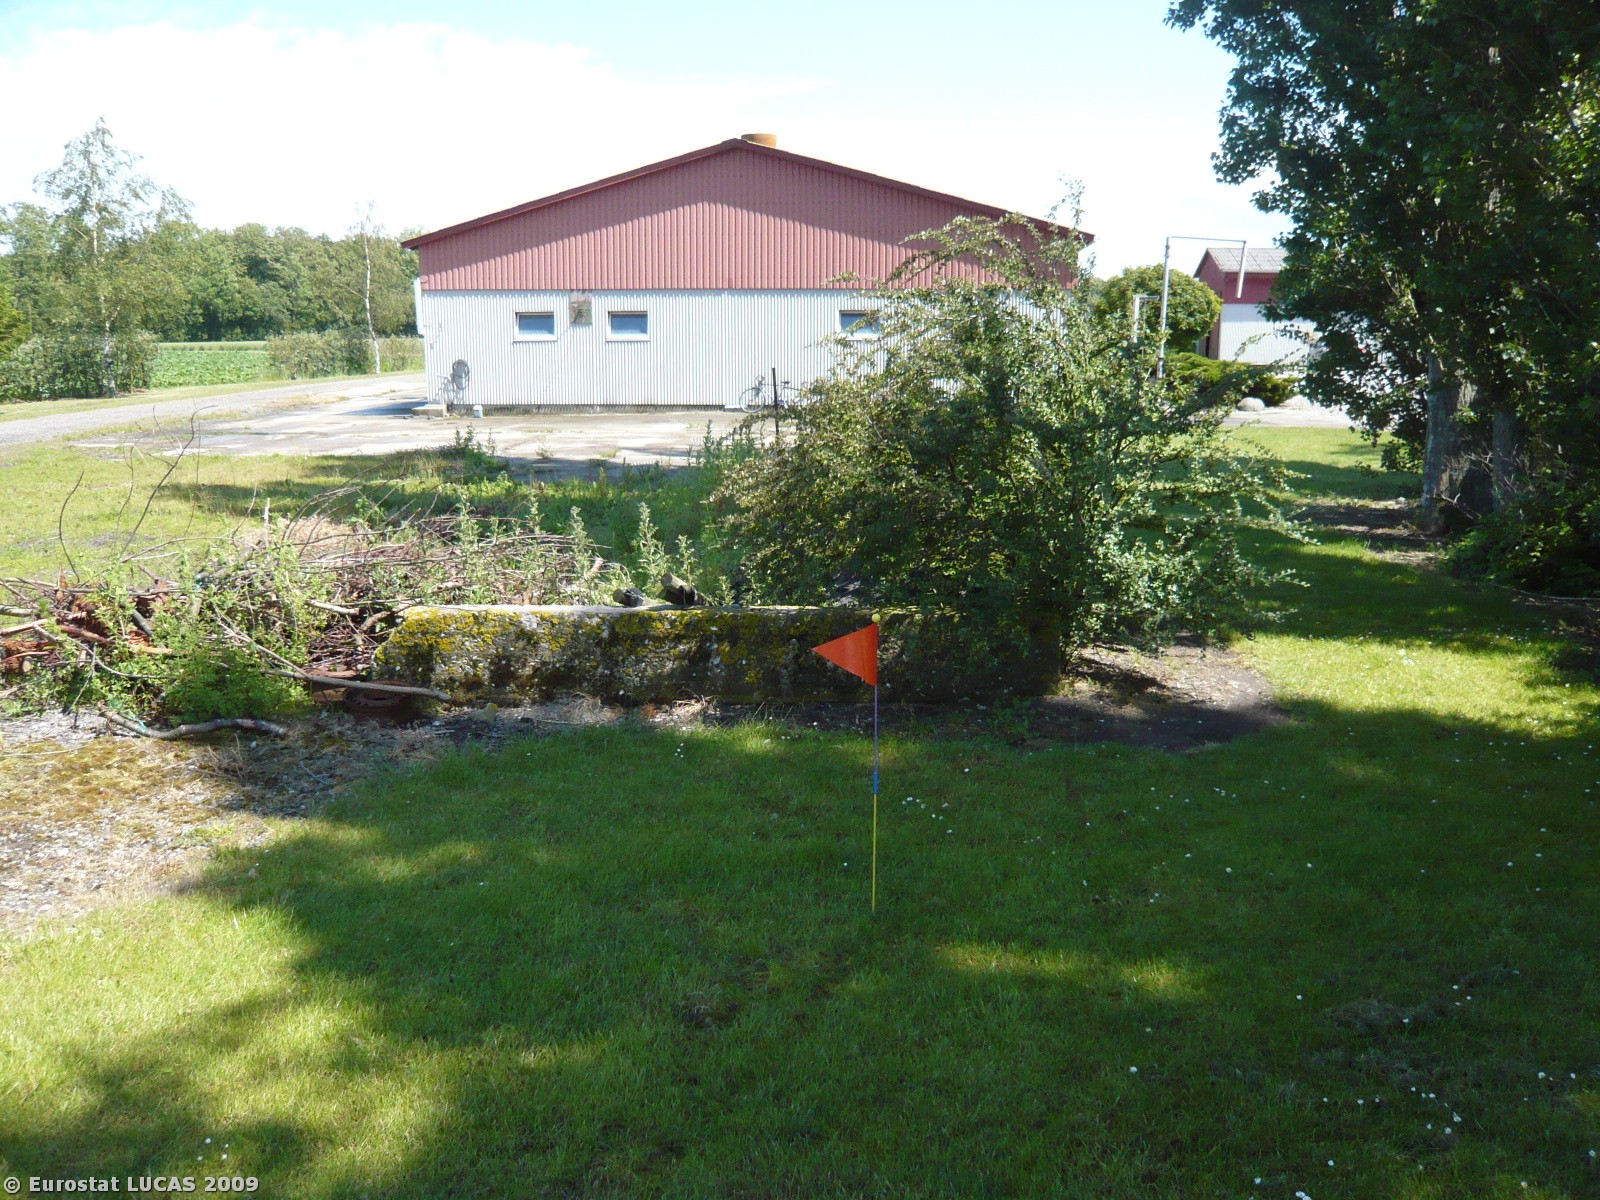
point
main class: Grassland
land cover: Grassland without tree/shrub cover
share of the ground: > 75 %
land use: Residential
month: June
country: DK
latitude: 54.7950
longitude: 11.4766
